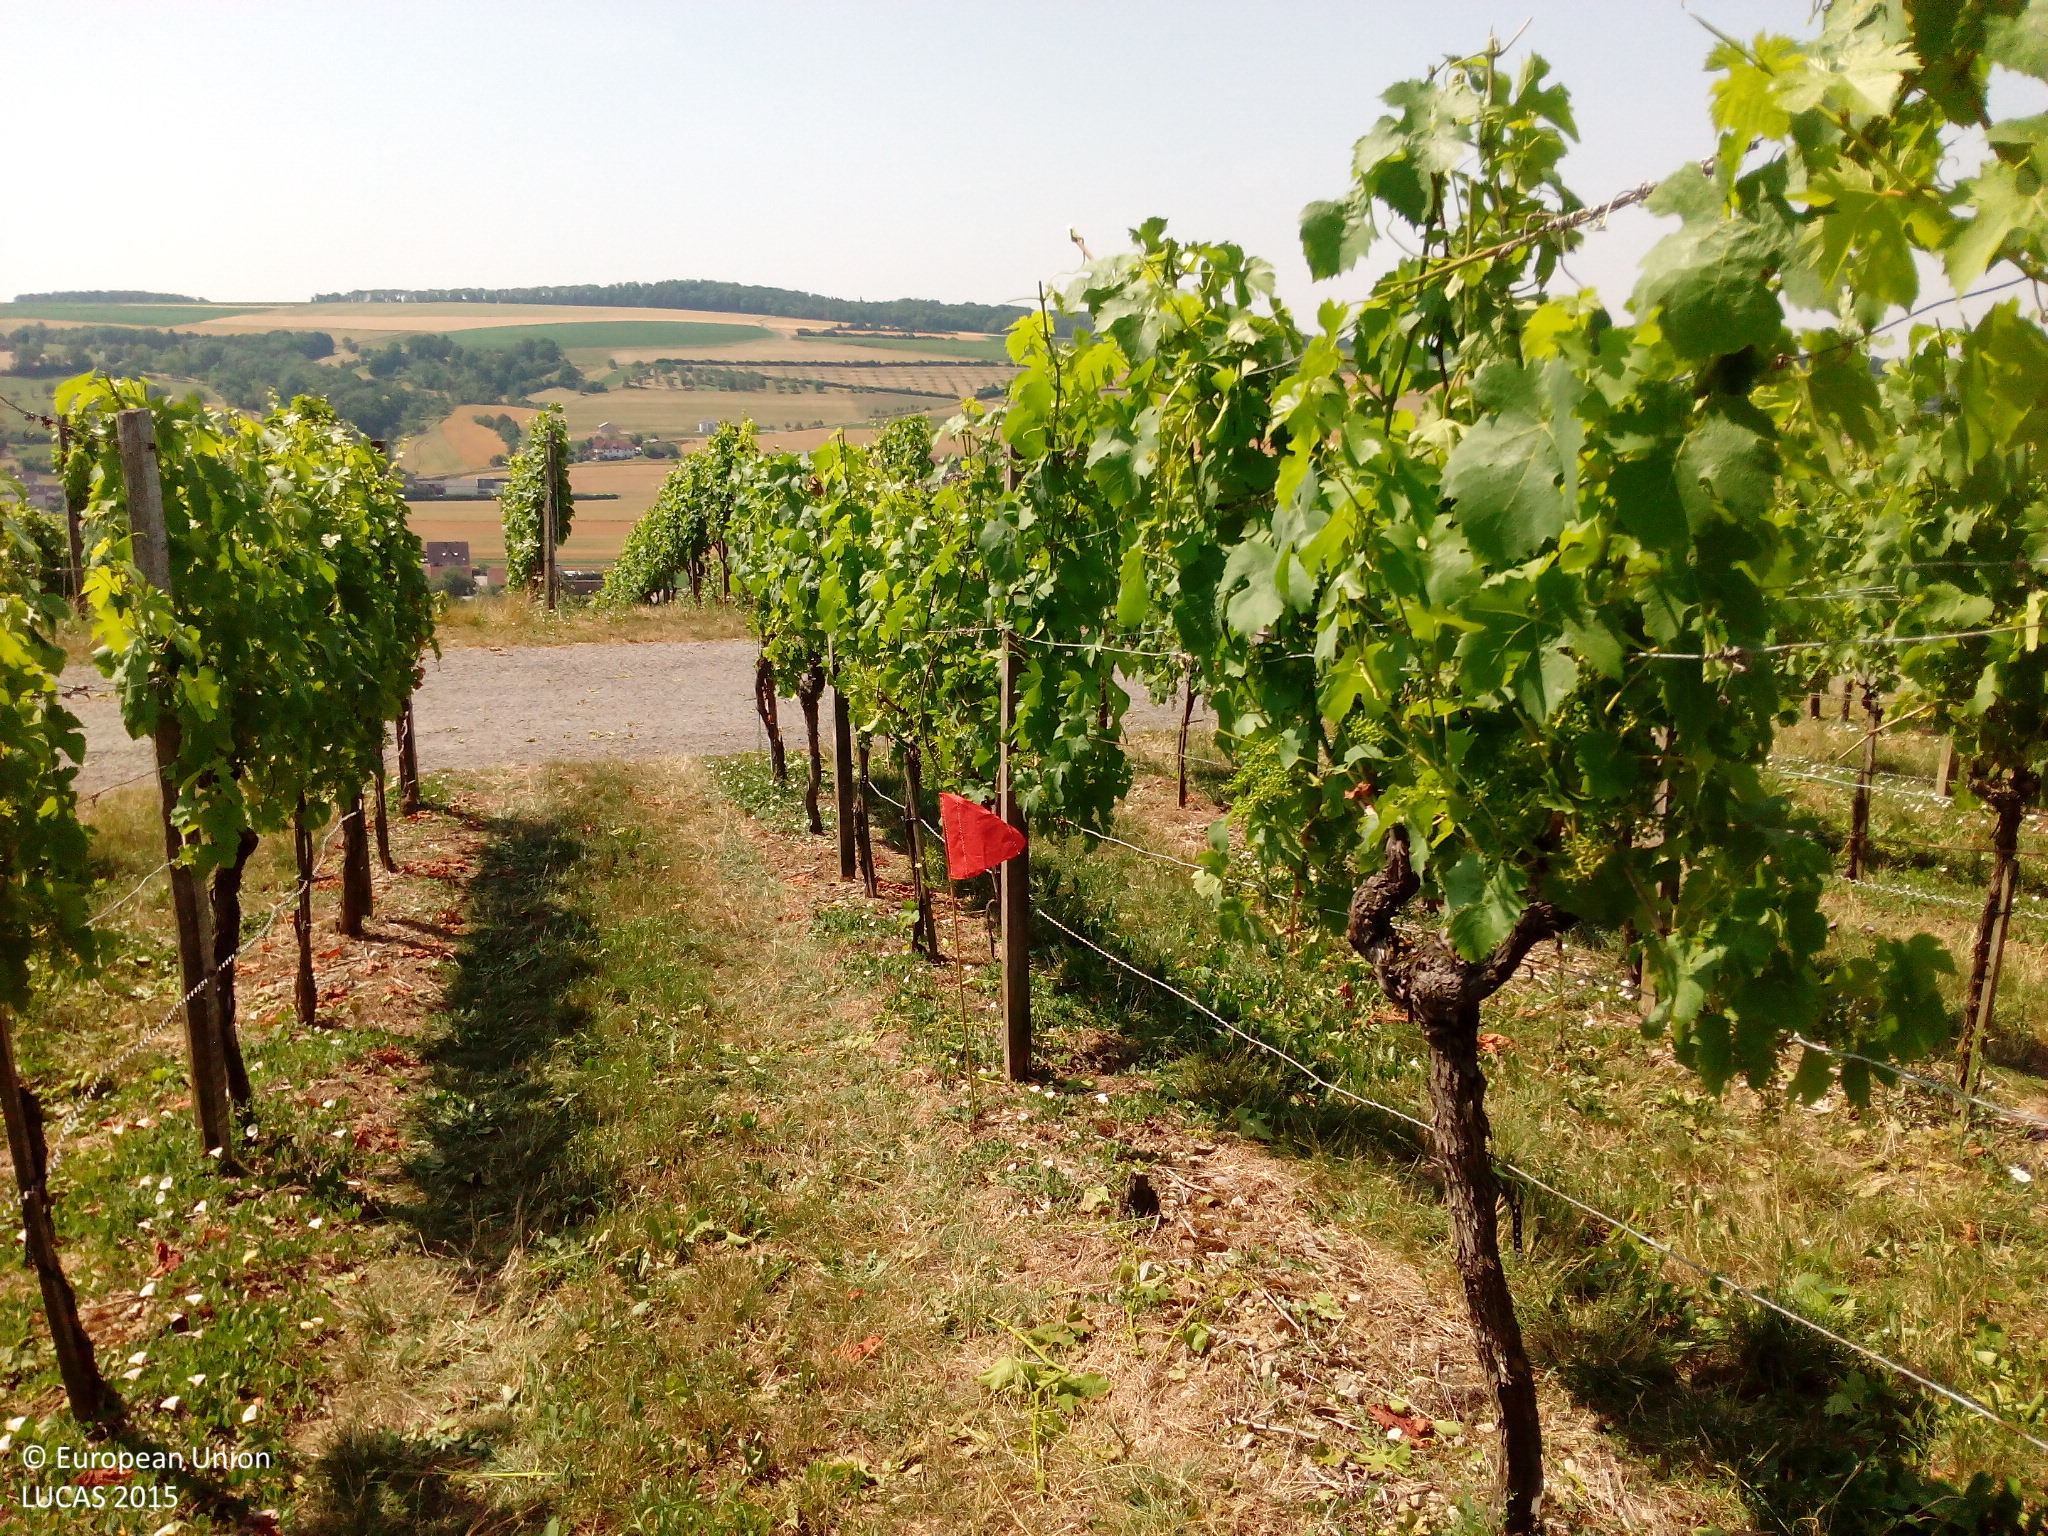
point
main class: Cropland
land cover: Vineyards
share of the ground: 25 - 50 %
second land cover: Spontaneously vegetated surfaces
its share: > 75 %
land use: Agriculture (excluding fallow land and kitchen gardens)
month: July
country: DE
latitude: 49.5008
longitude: 9.9310
